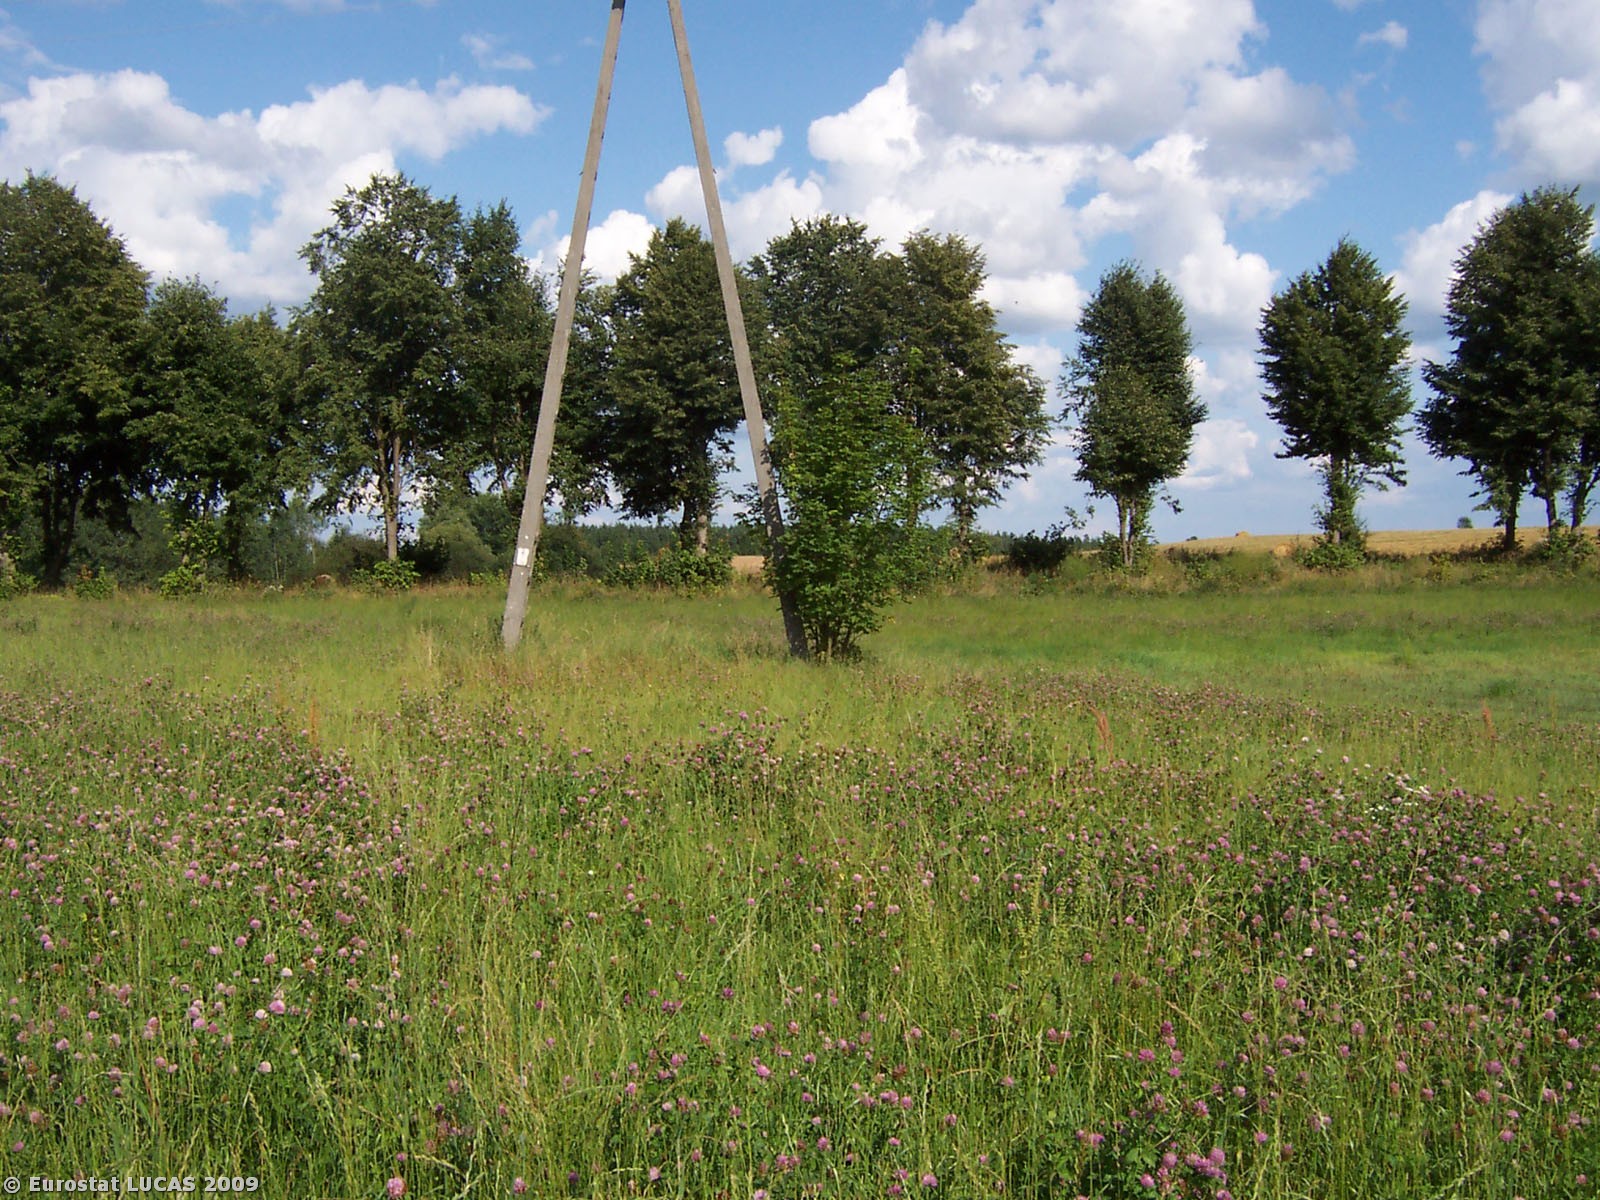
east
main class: Cropland
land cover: Clovers
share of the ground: > 75 %
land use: Agriculture (excluding fallow land and kitchen gardens)
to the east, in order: Clovers; Electric lines; Clovers; Grass margins; Lines of trees; Grass margins; Paved roads, cycling and walking lanes; Grass margins; Lines of trees; Grass margins; Oats
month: August
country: PL
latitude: 53.7257
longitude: 21.0931
